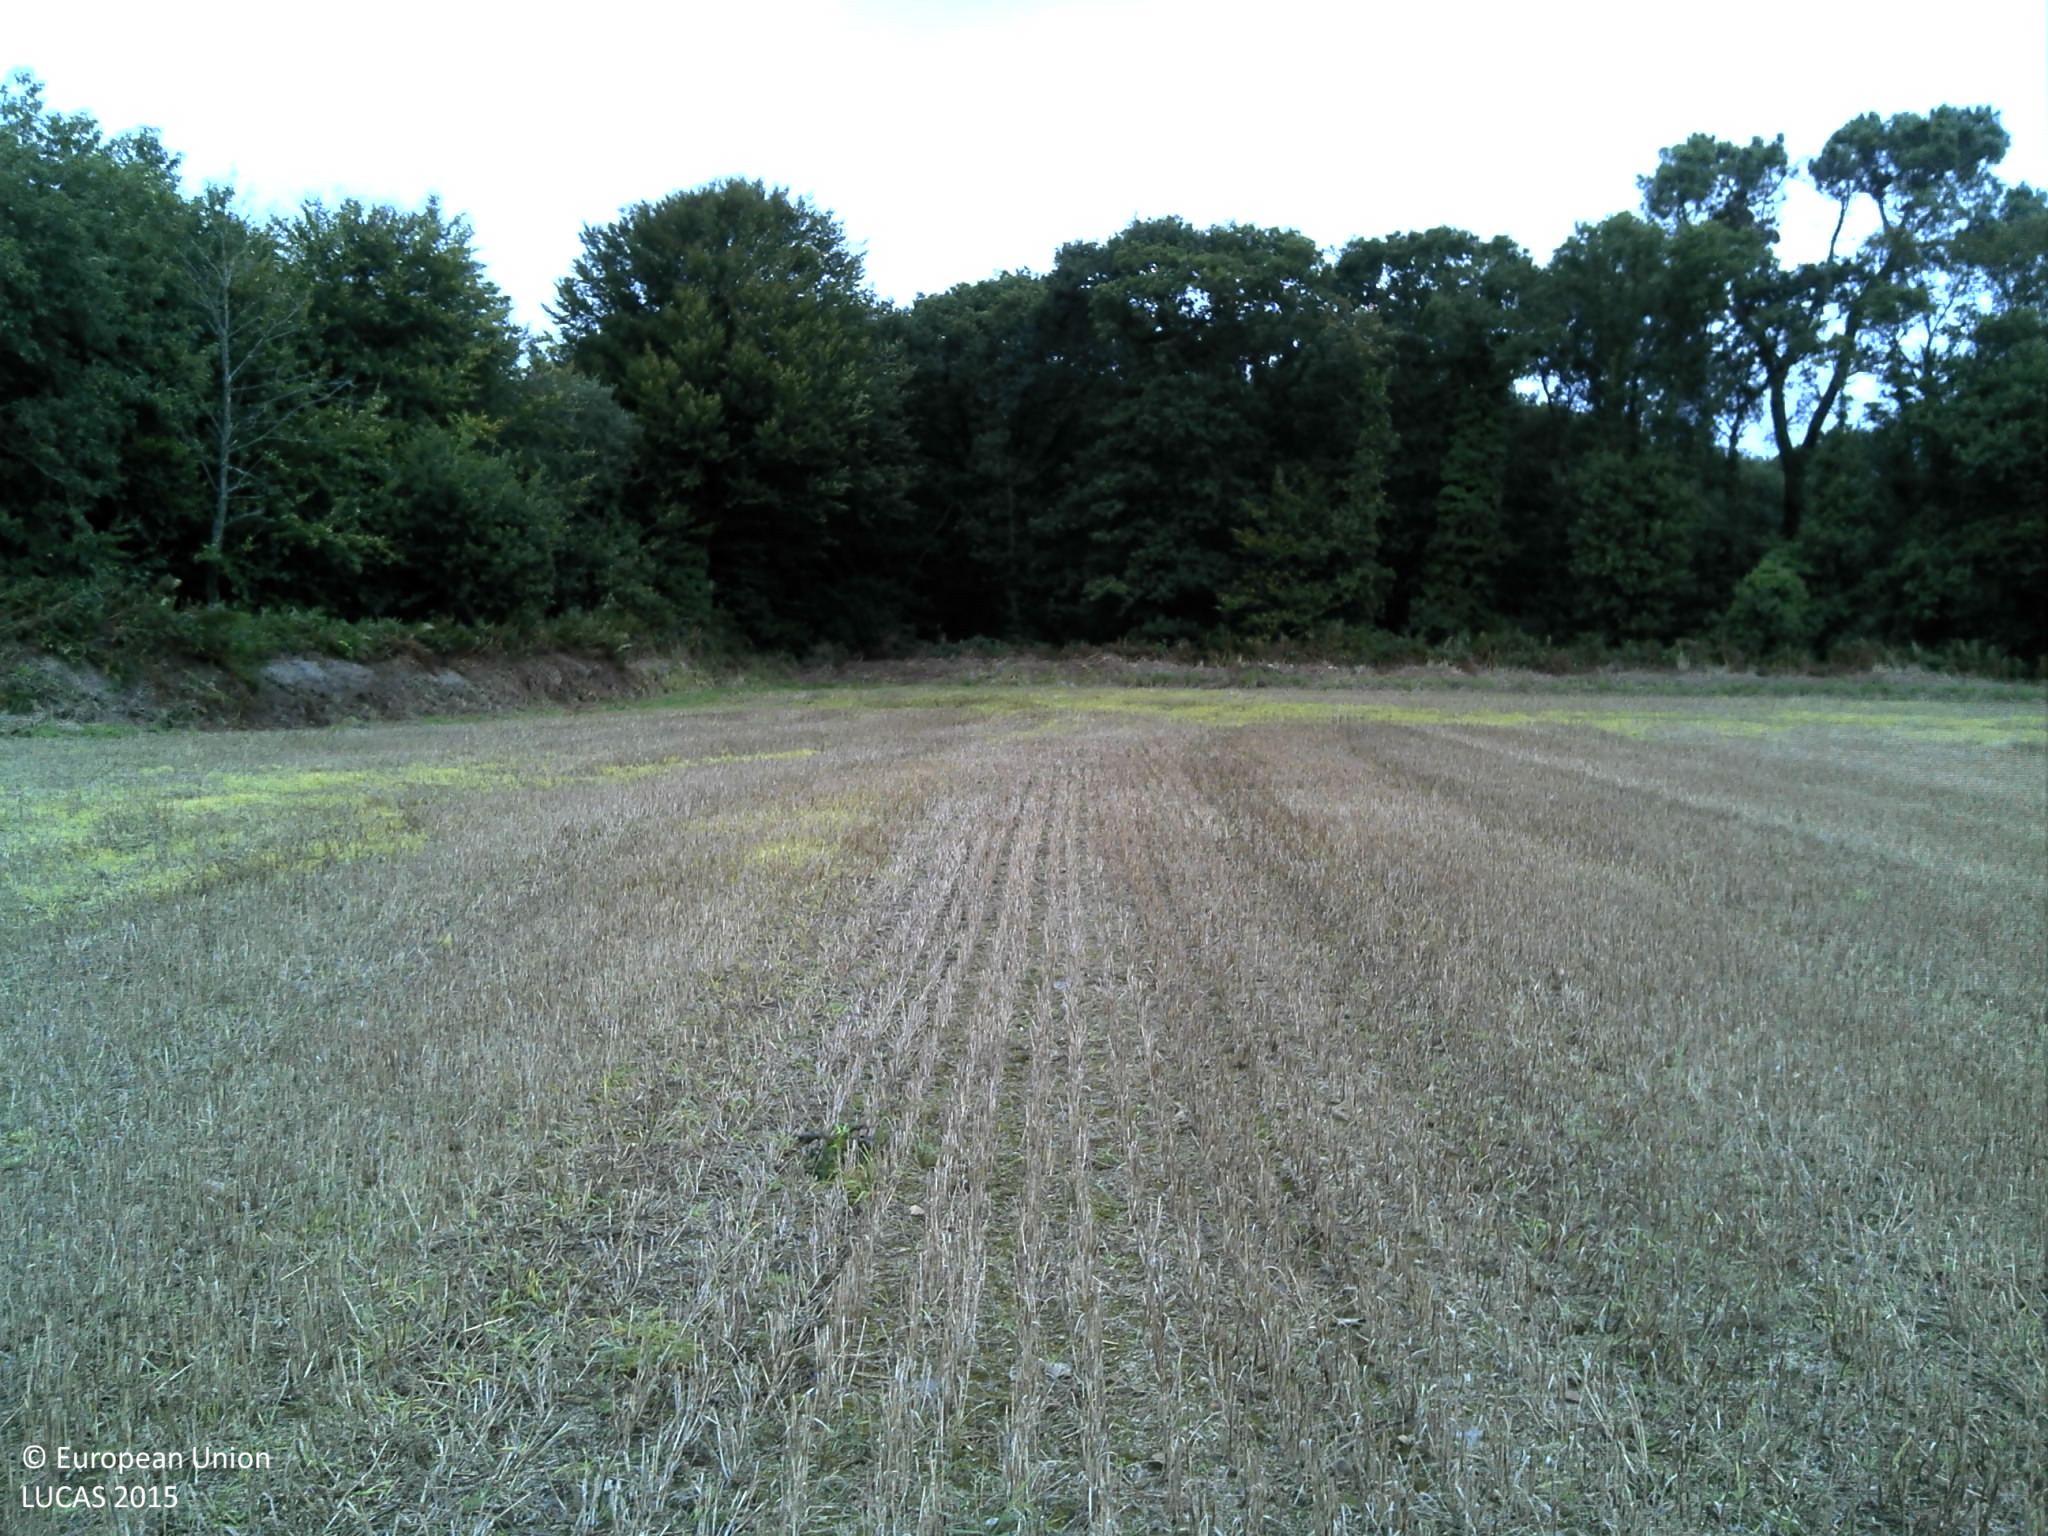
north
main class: Cropland
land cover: Common wheat
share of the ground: 50 - 75 %
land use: Agriculture (excluding fallow land and kitchen gardens)
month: September
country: FR
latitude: 48.5346
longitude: -4.2462
